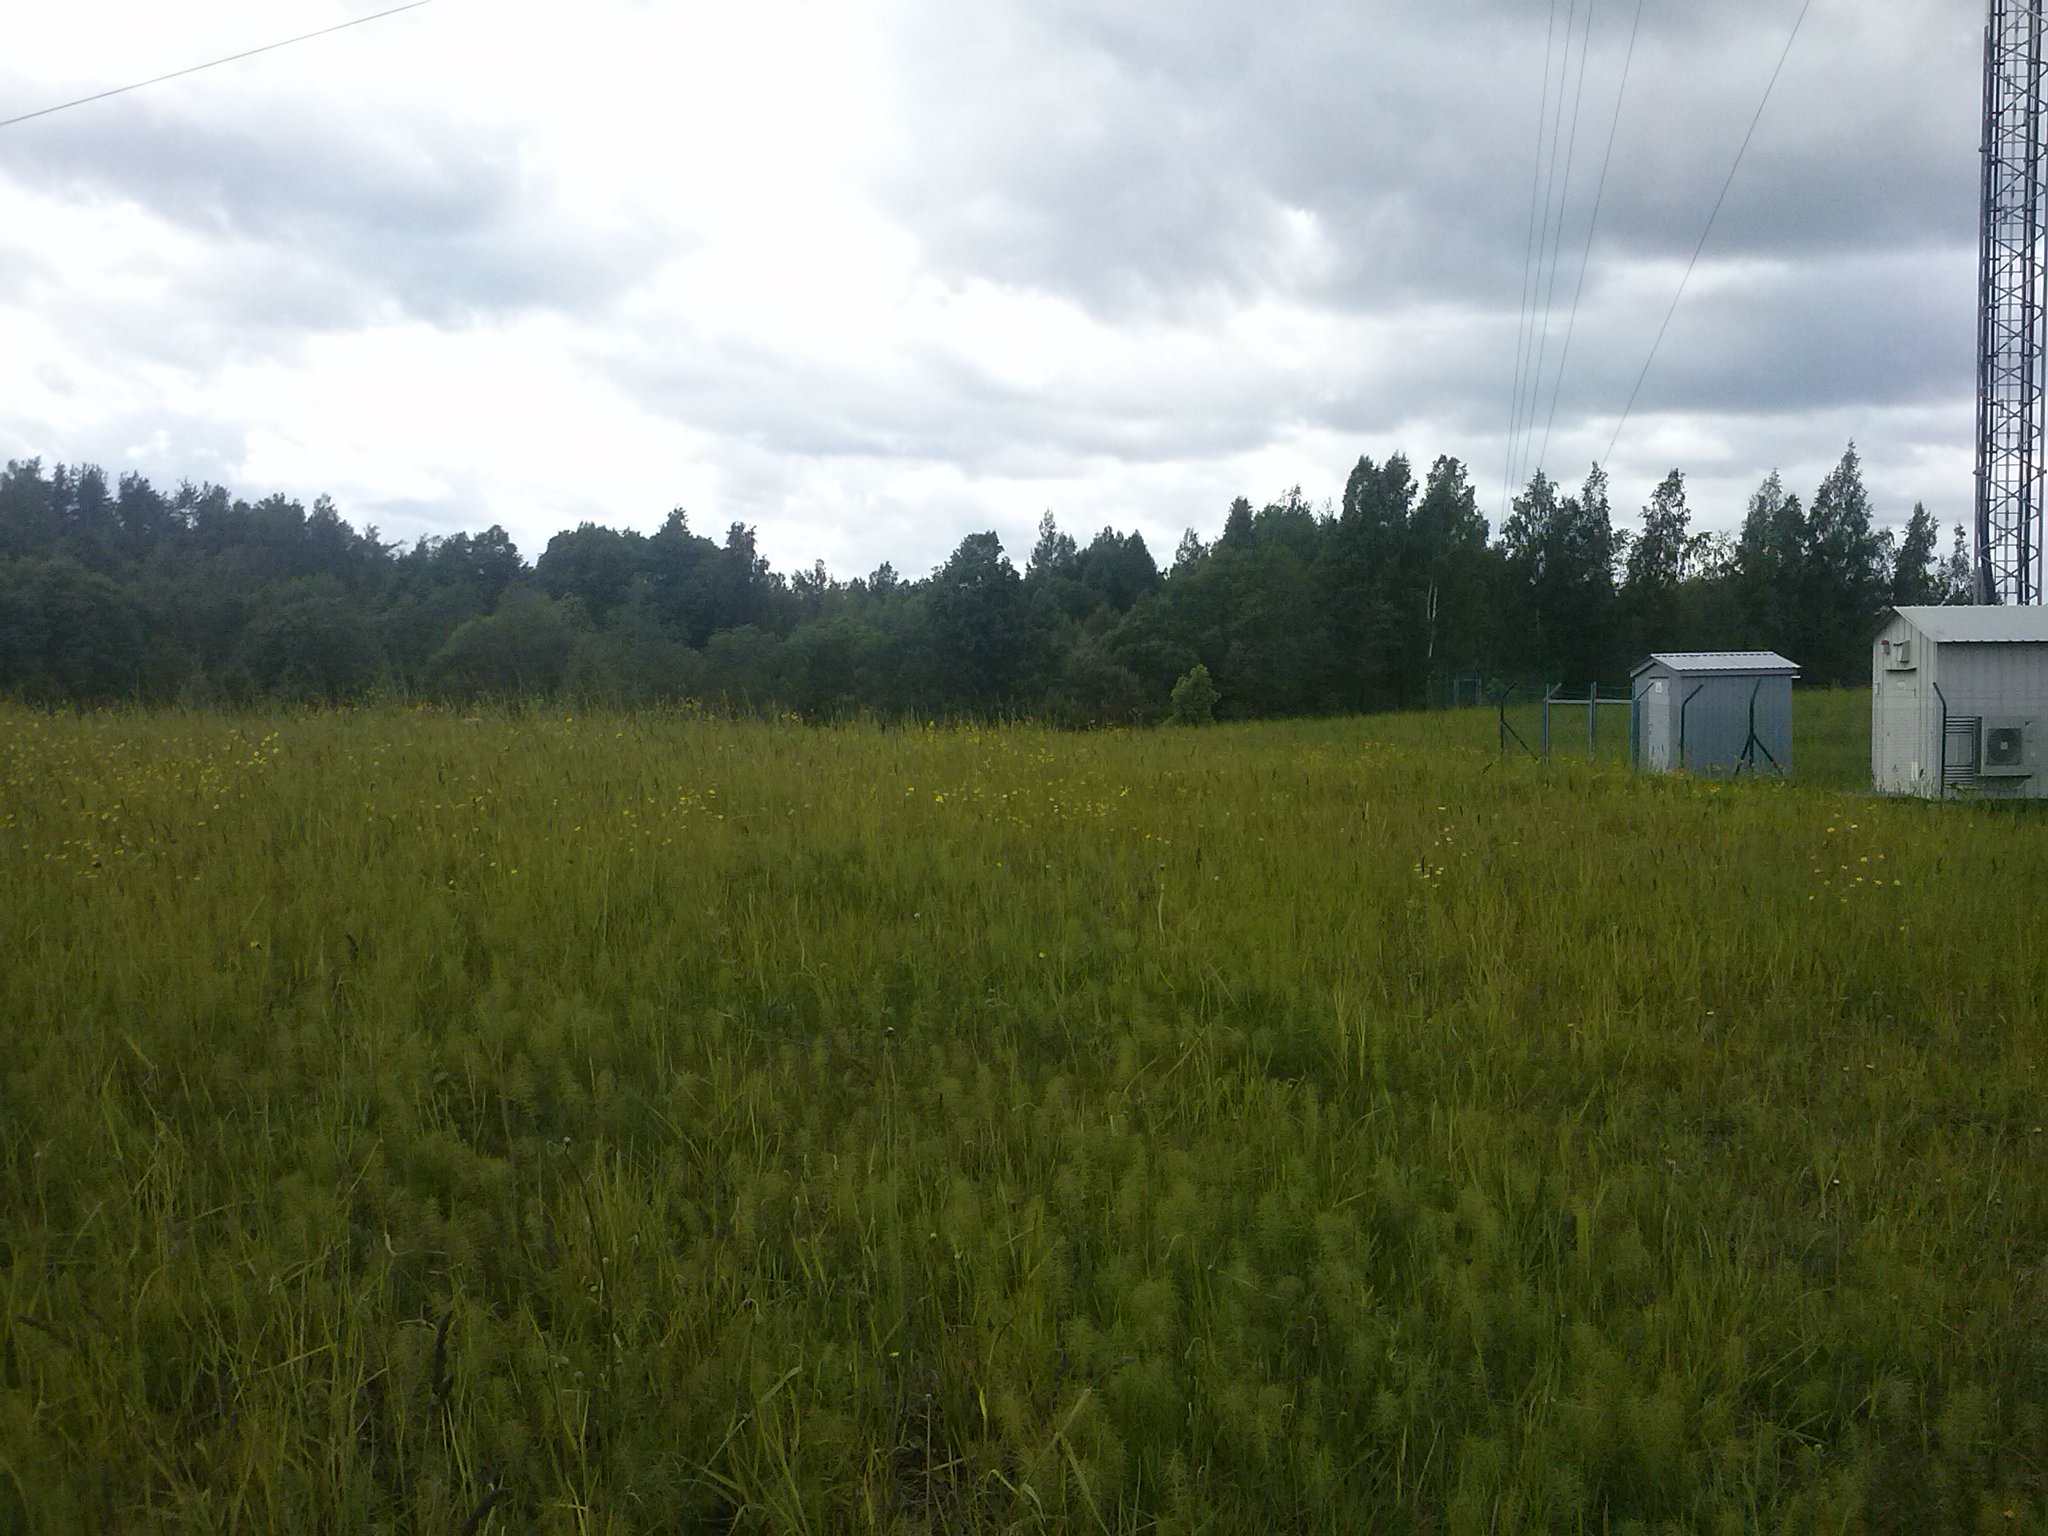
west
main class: Grassland
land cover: Grassland without tree/shrub cover
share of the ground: > 75 %
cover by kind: herbaceous plants 100 %
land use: Agriculture (excluding fallow land and kitchen gardens)
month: June
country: LV
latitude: 56.2663
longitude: 27.6055
